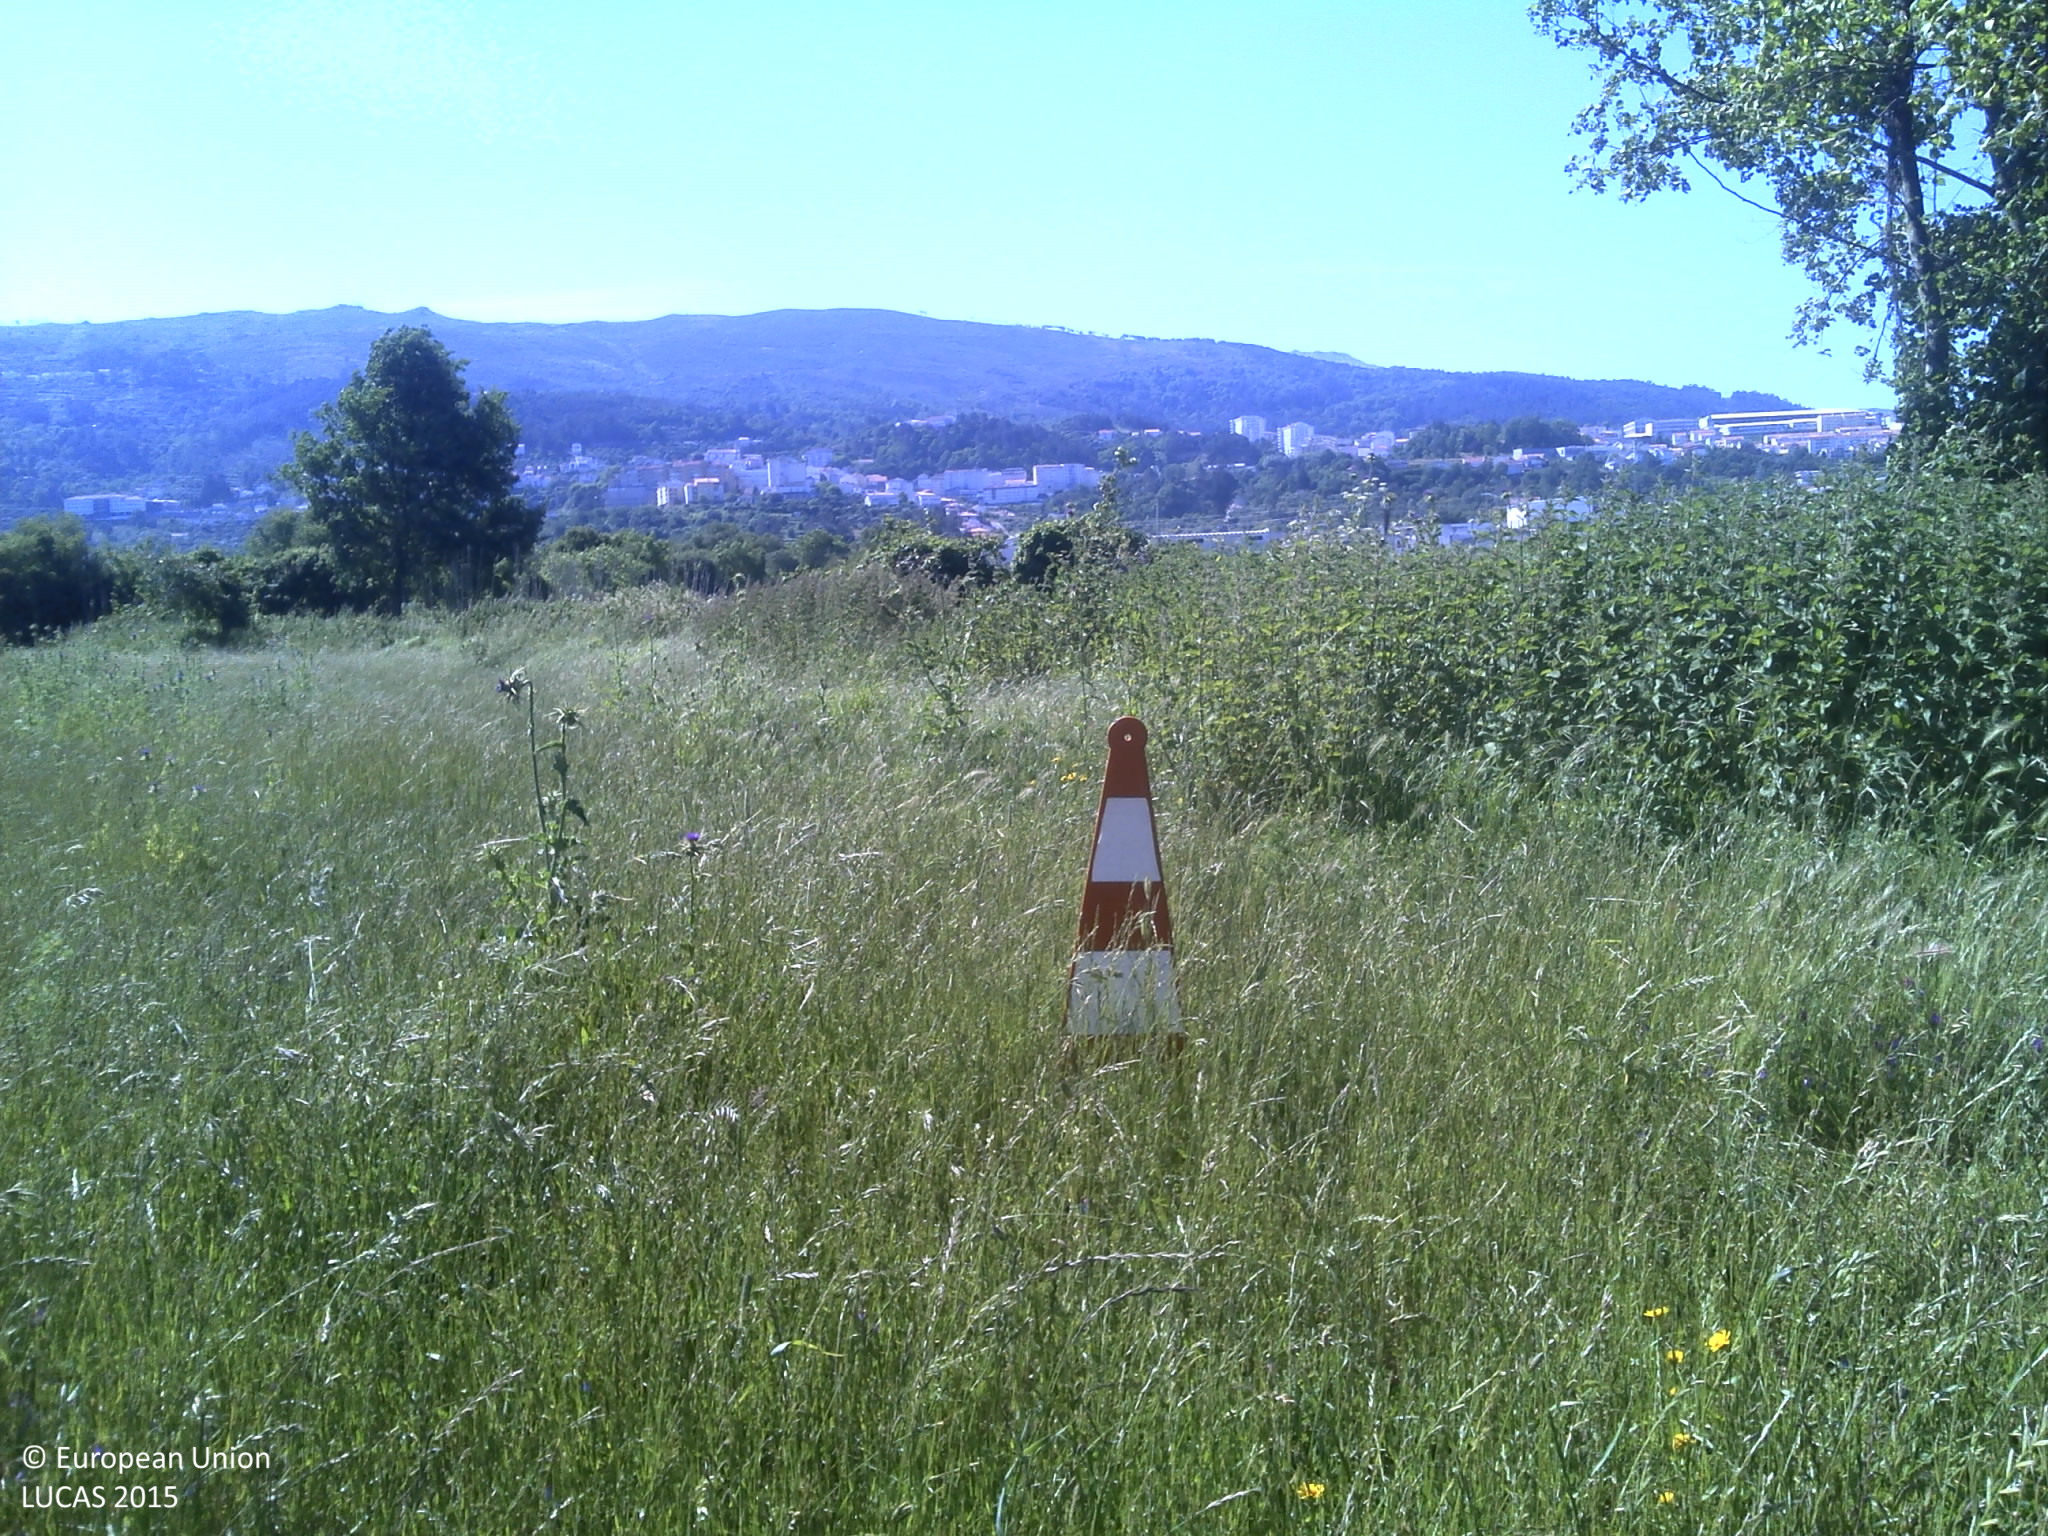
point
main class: Grassland
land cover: Grassland without tree/shrub cover
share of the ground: > 75 %
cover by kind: herbaceous plants 90 %, unconsolidated bare surface 10 %
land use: Agriculture (excluding fallow land and kitchen gardens)
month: May
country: PT
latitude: 40.4319
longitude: -7.7146
